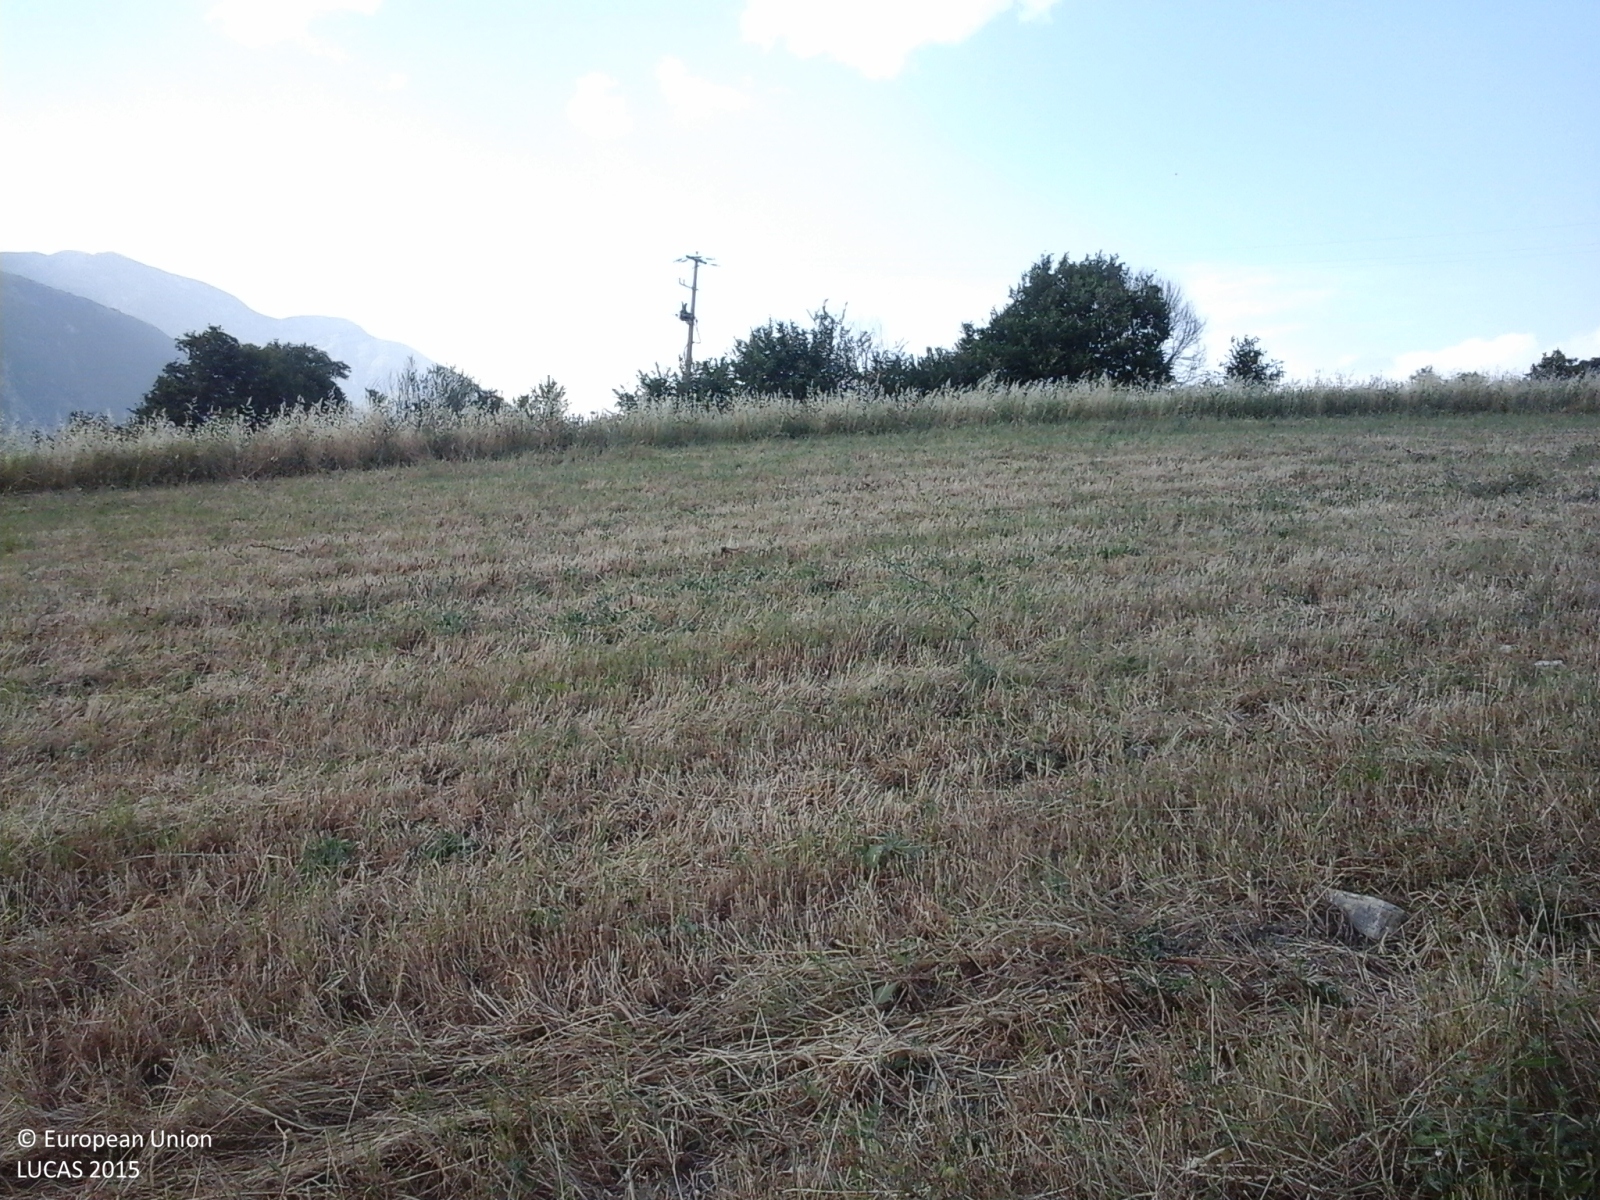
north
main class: Cropland
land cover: Other leguminous and mixtures for fodder
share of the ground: > 75 %
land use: Agriculture (excluding fallow land and kitchen gardens)
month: June
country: IT
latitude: 42.0233
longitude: 14.2253
